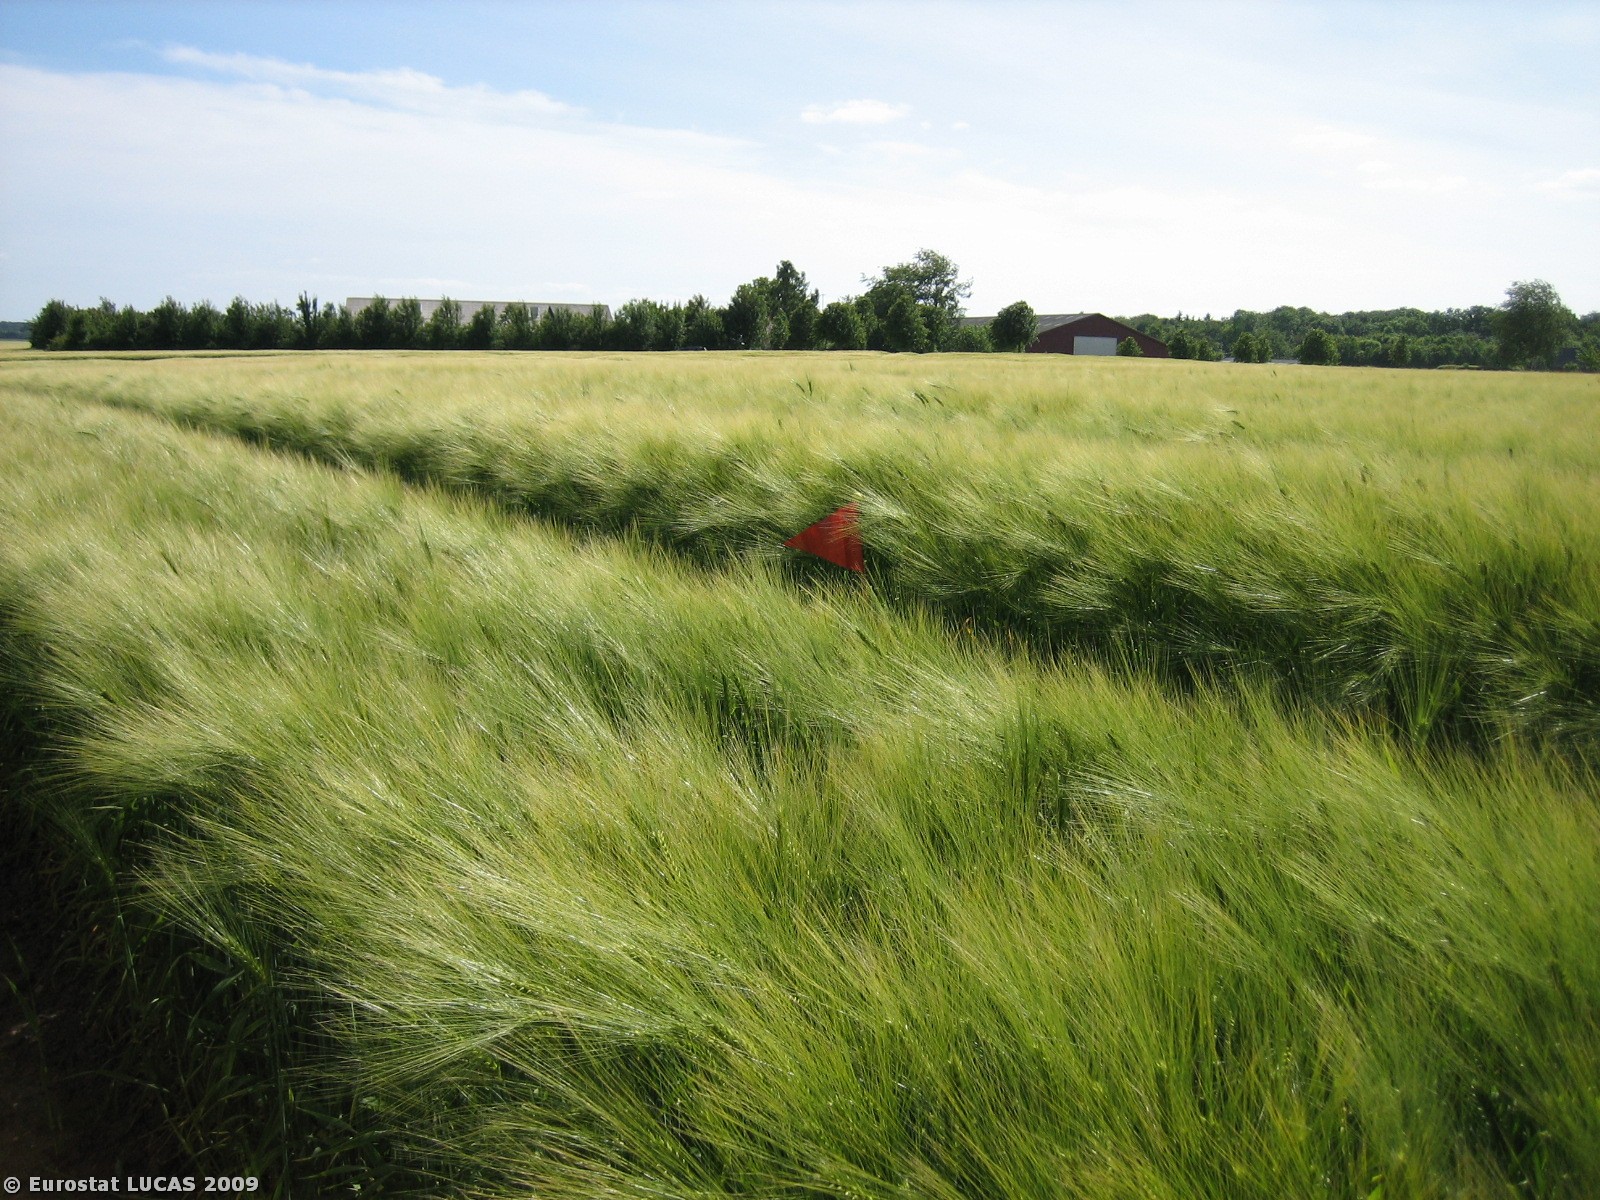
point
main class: Cropland
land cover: Barley
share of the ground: > 75 %
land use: Agriculture (excluding fallow land and kitchen gardens)
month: June
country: DK
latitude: 55.7203
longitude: 9.8569
